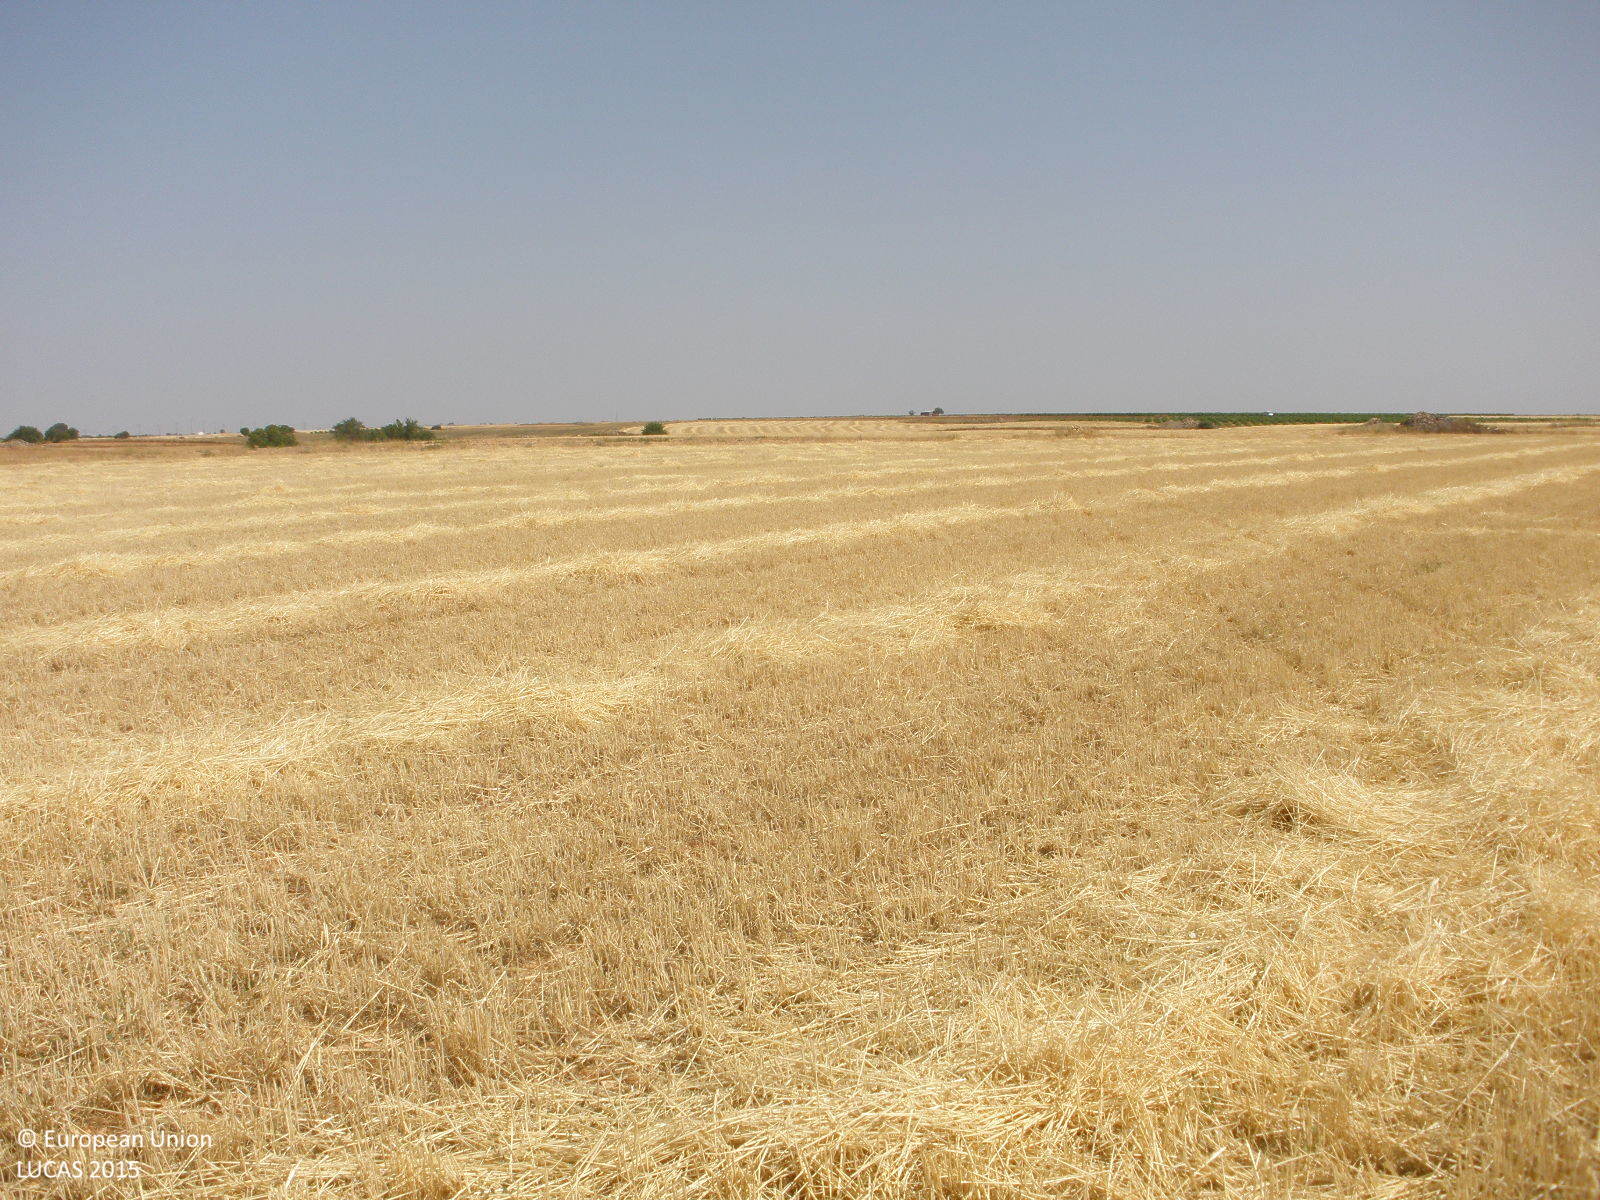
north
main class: Cropland
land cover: Common wheat
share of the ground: < 10 %
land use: Agriculture (excluding fallow land and kitchen gardens)
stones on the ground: 10 - 25 %
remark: Harvested field
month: July
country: ES
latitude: 39.9252
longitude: -3.1642
